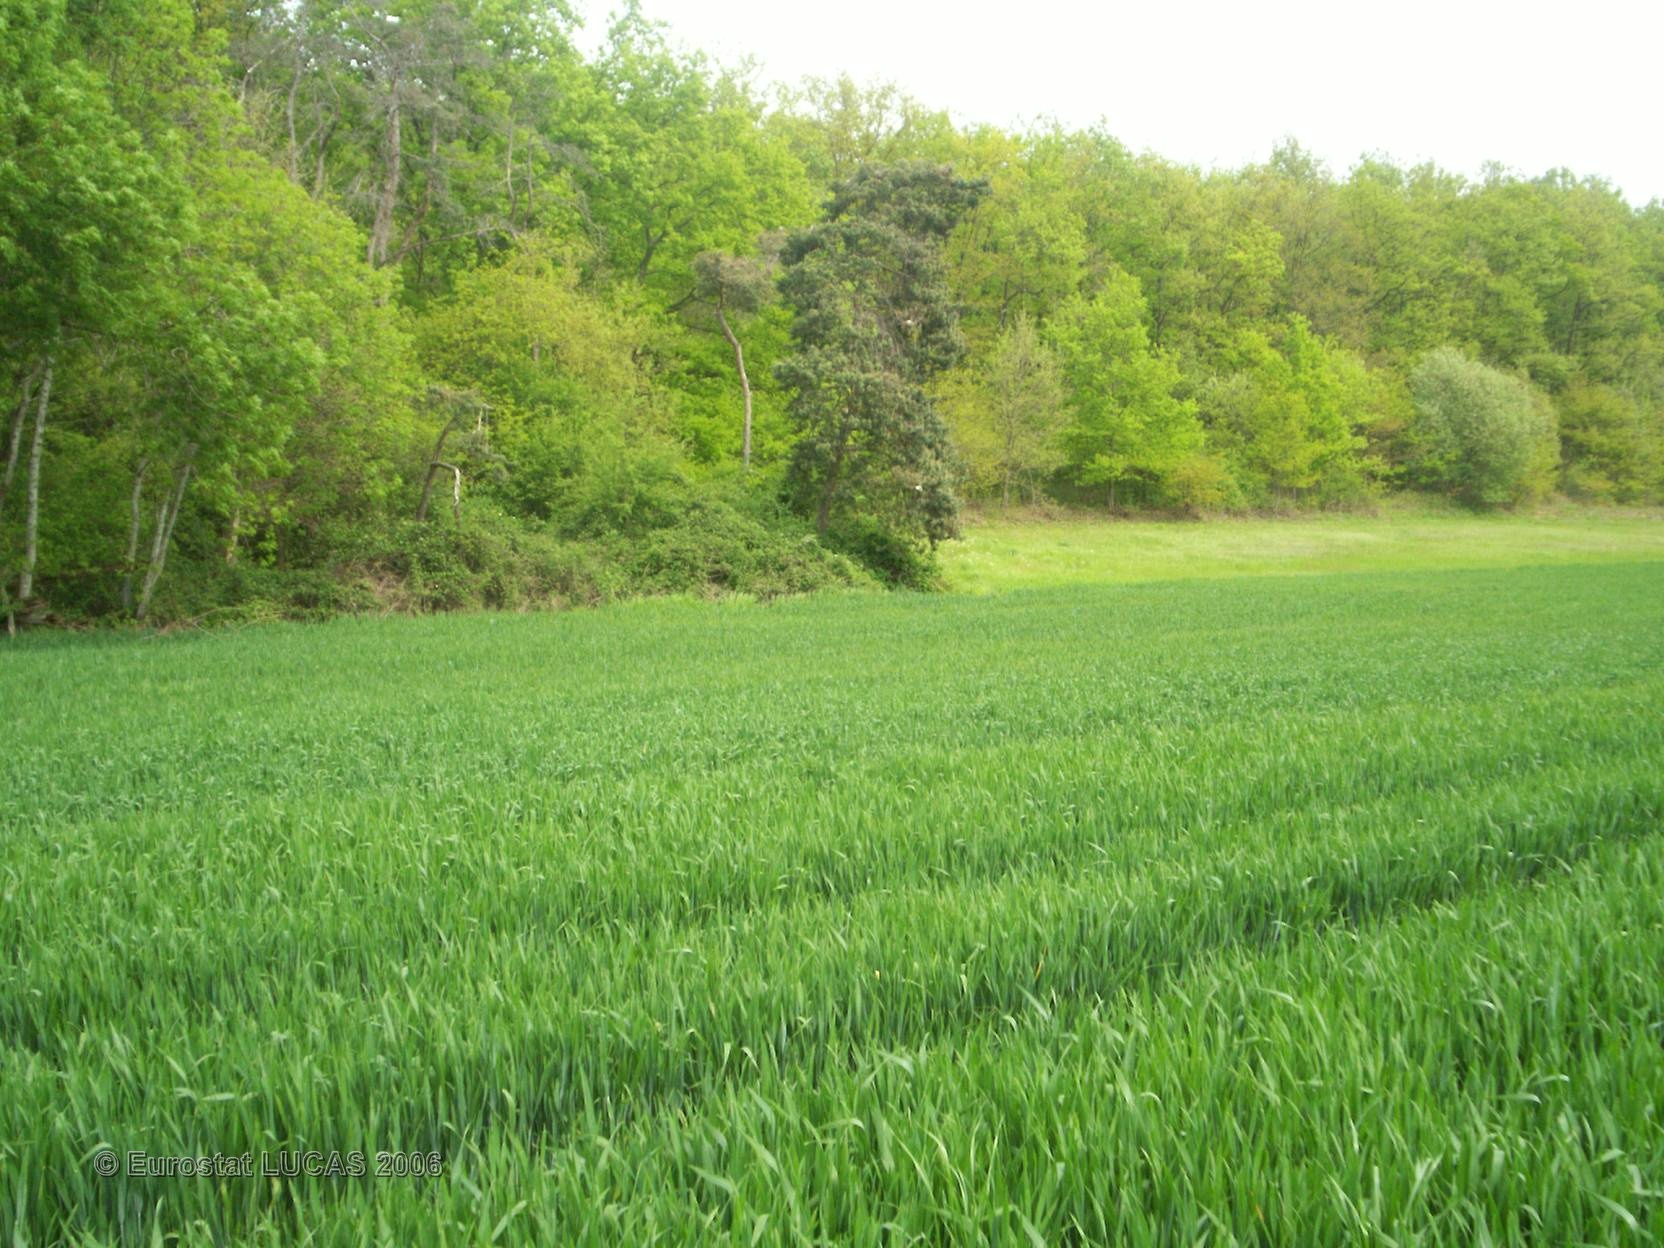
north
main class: Cropland
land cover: Common wheat
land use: Agriculture (excluding fallow land and kitchen gardens)
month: May
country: FR
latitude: 46.2441
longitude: 3.2156
